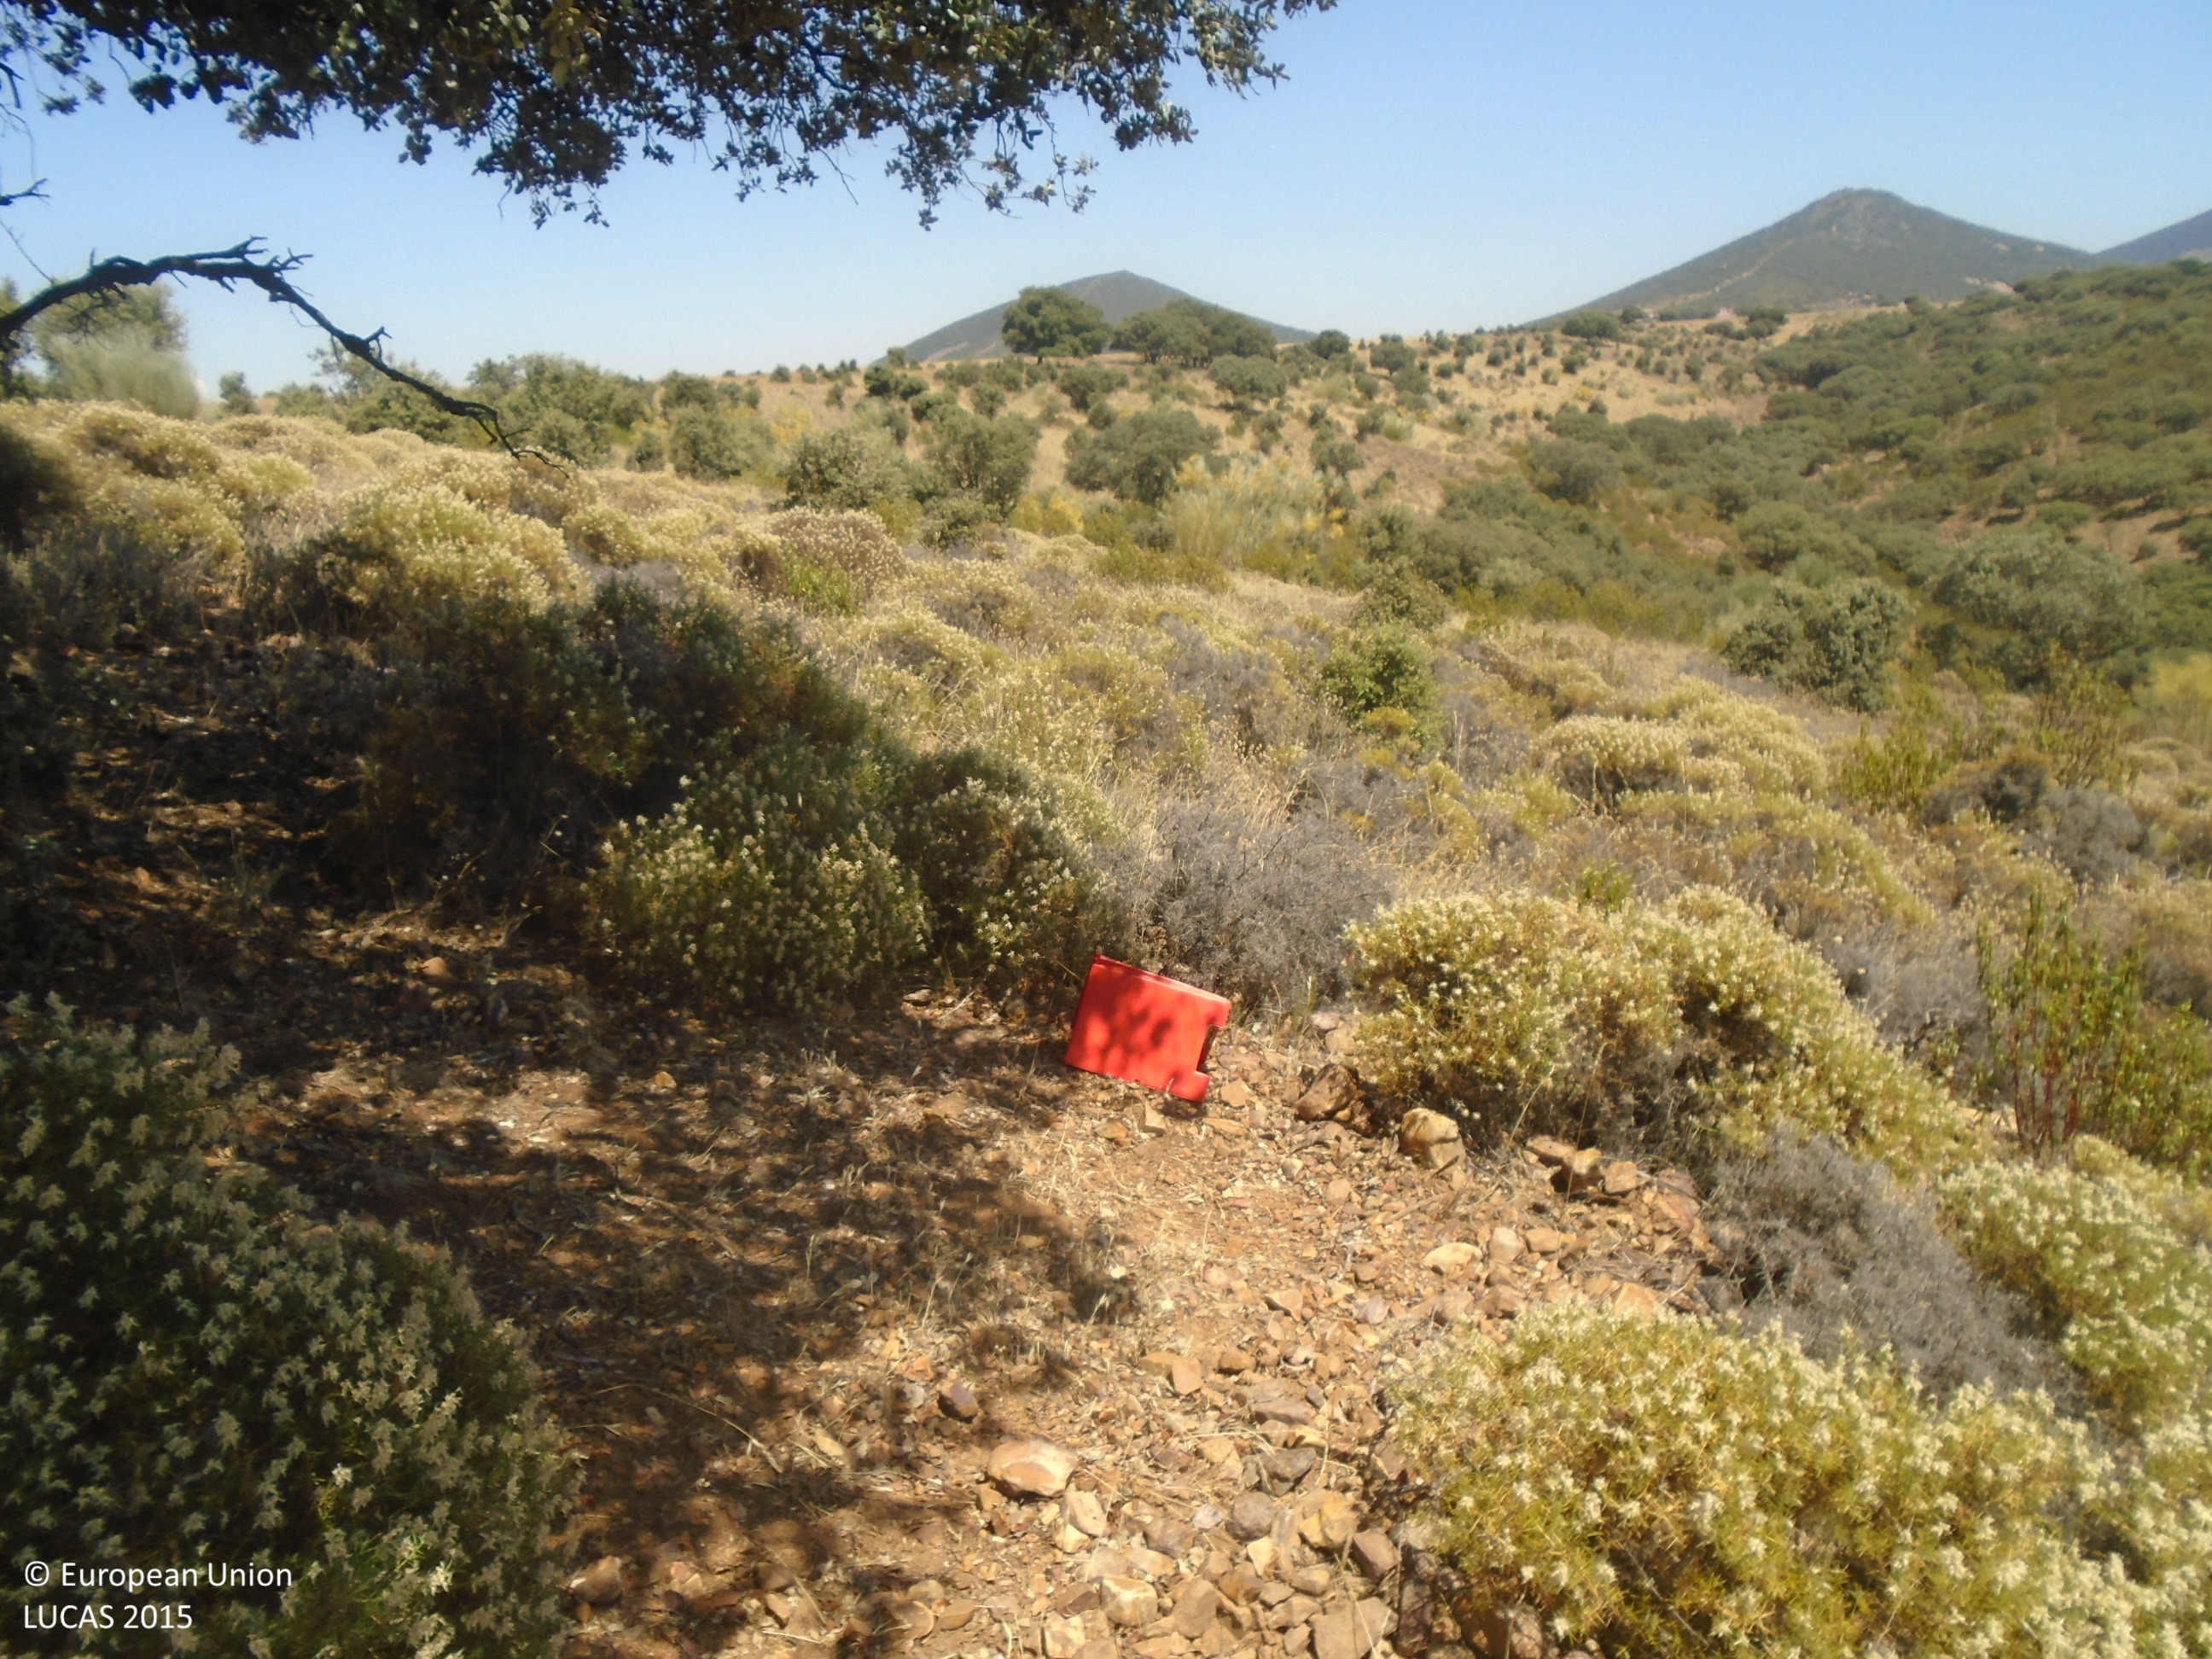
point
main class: Shrubland
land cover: Shrubland with sparse tree cover
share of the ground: > 75 %
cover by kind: shrubs 95 %, broadleaved forest trees 5 %
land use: Semi-natural and natural areas not in use
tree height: > 5 m
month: July
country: ES
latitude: 39.6968
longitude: -4.9852
